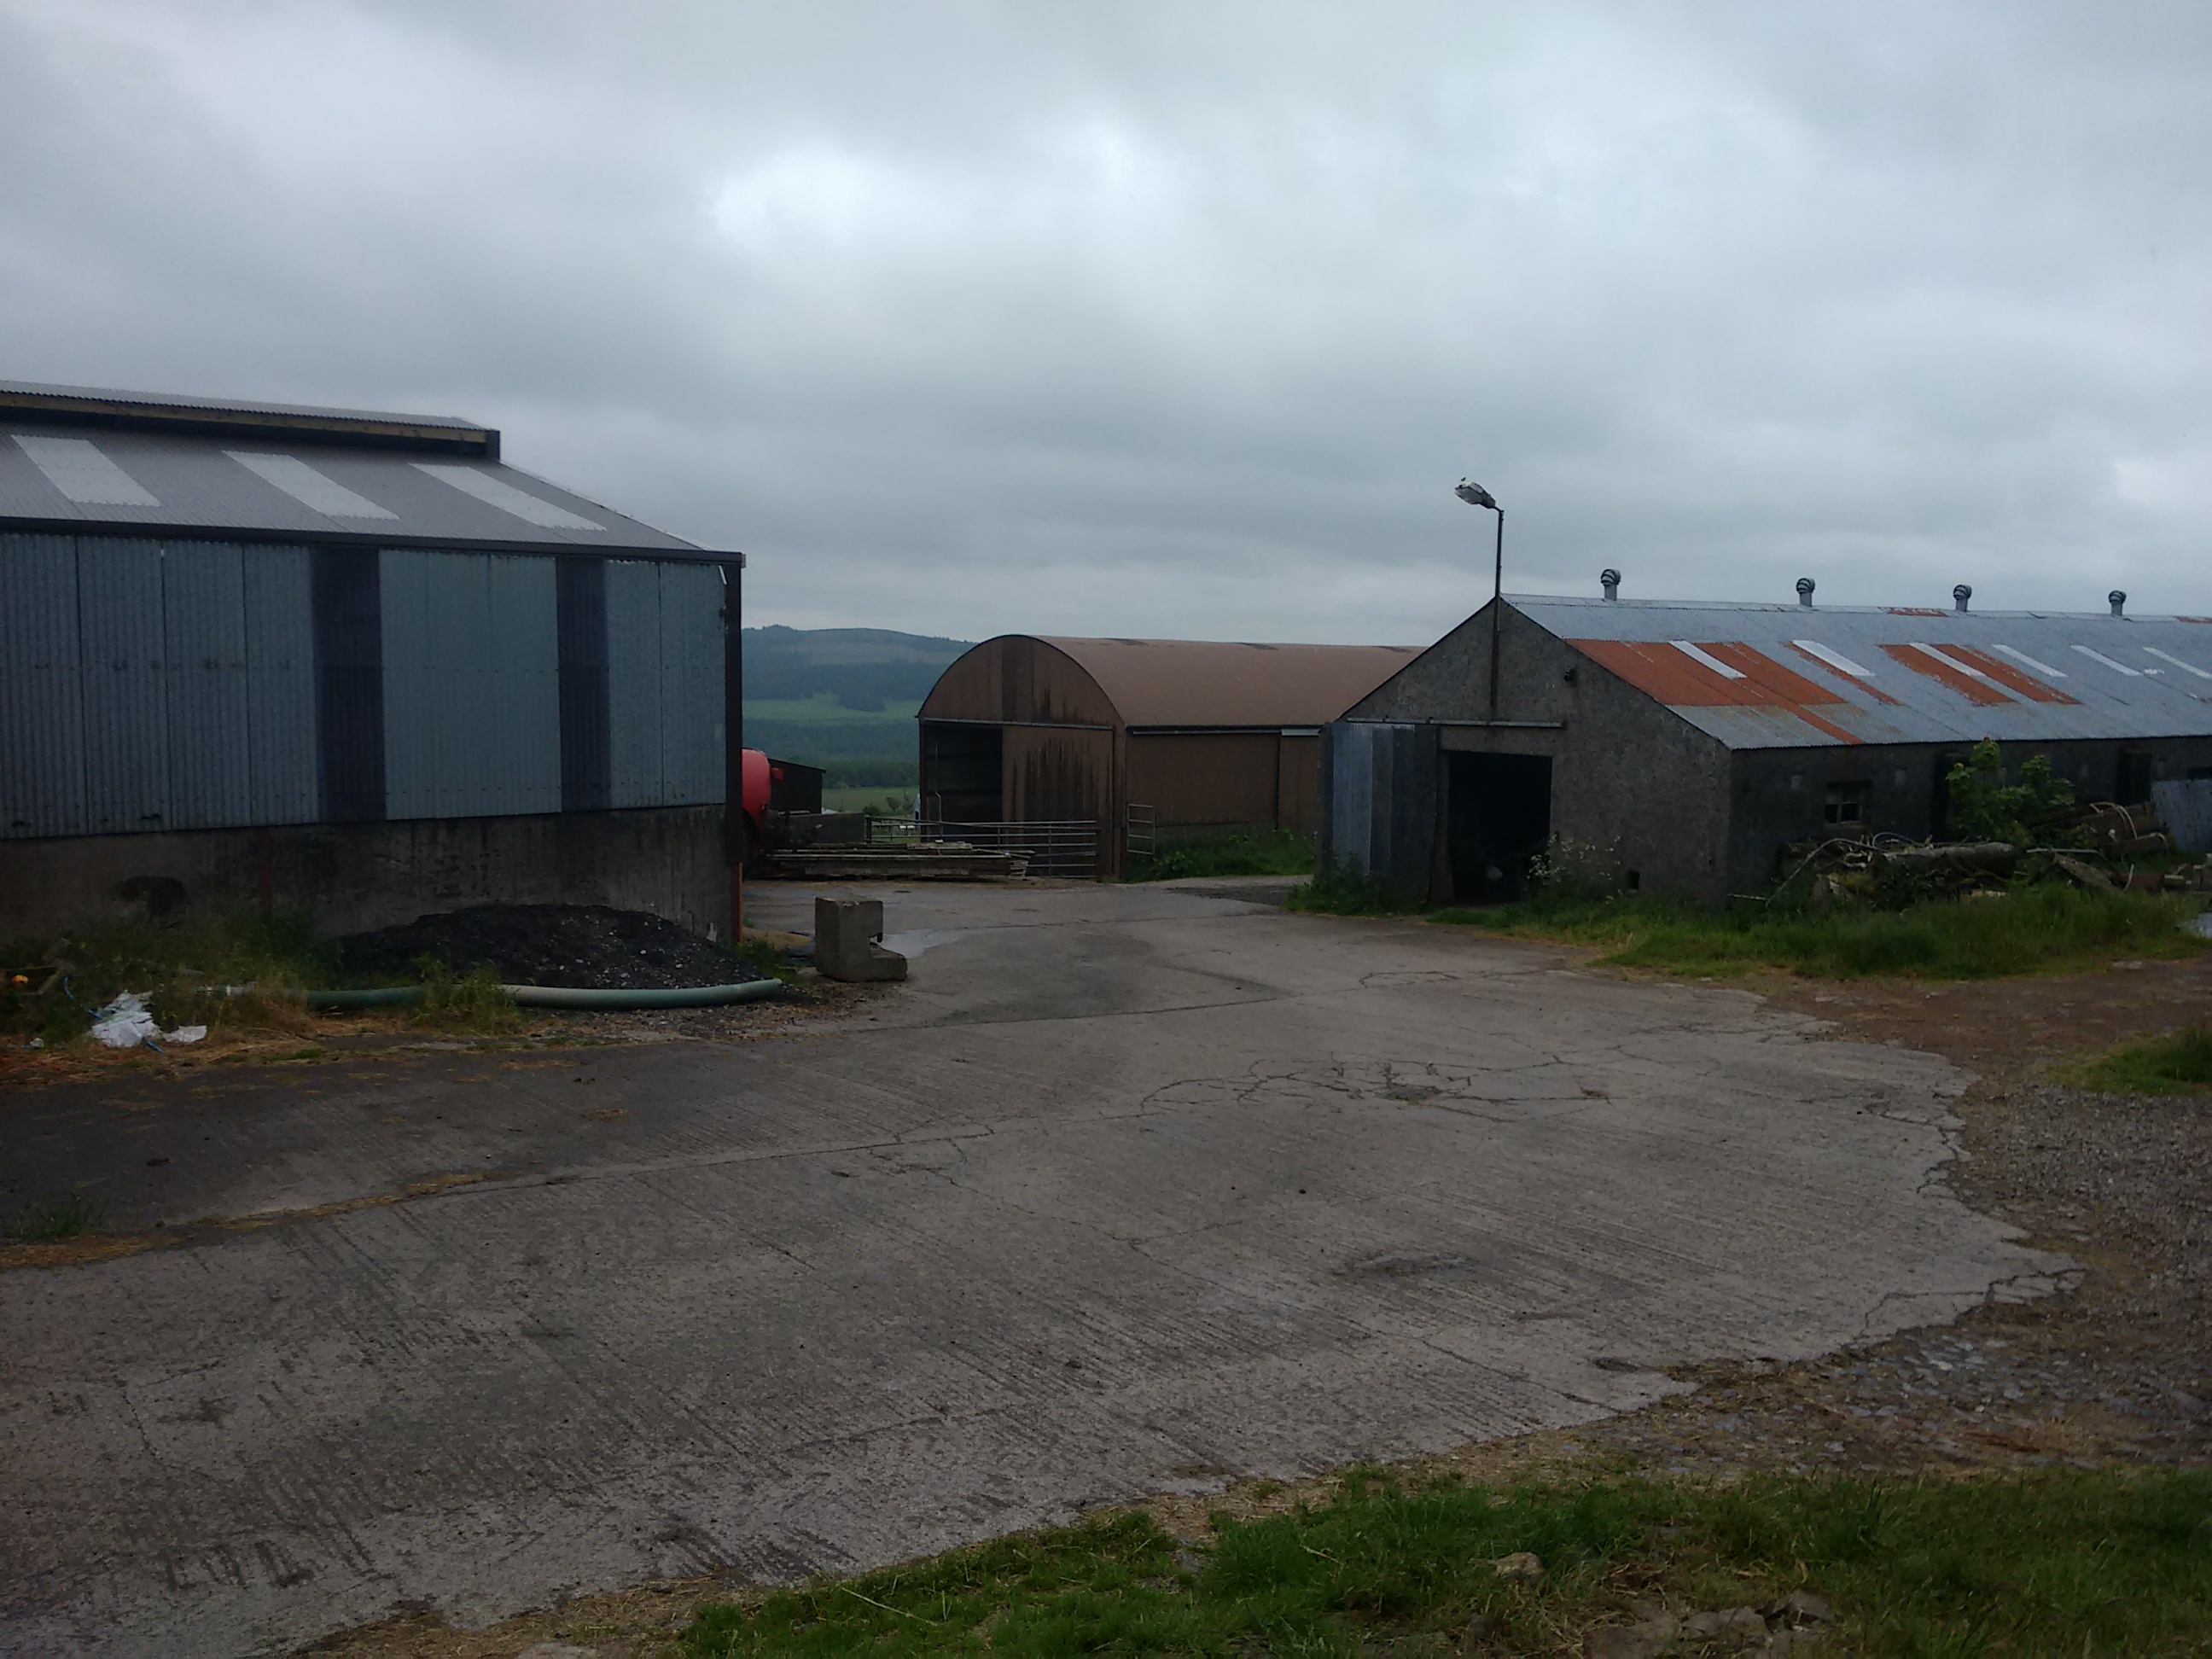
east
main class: Grassland
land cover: Grassland without tree/shrub cover
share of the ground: > 75 %
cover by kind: herbaceous plants 100 %
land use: Agriculture (excluding fallow land and kitchen gardens)
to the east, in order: Grassland without tree/shrub cover; Artificial constructions in urban areas; Grassland without tree/shrub cover; Fences; Abandoned hedges; Fences; Grassland without tree/shrub cover; Fences; Managed hedges; Paved roads, cycling and walking lanes; Grass margins; Fences; Grassland without tree/shrub cover
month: June
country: GB
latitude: 54.6783
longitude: -7.4781
